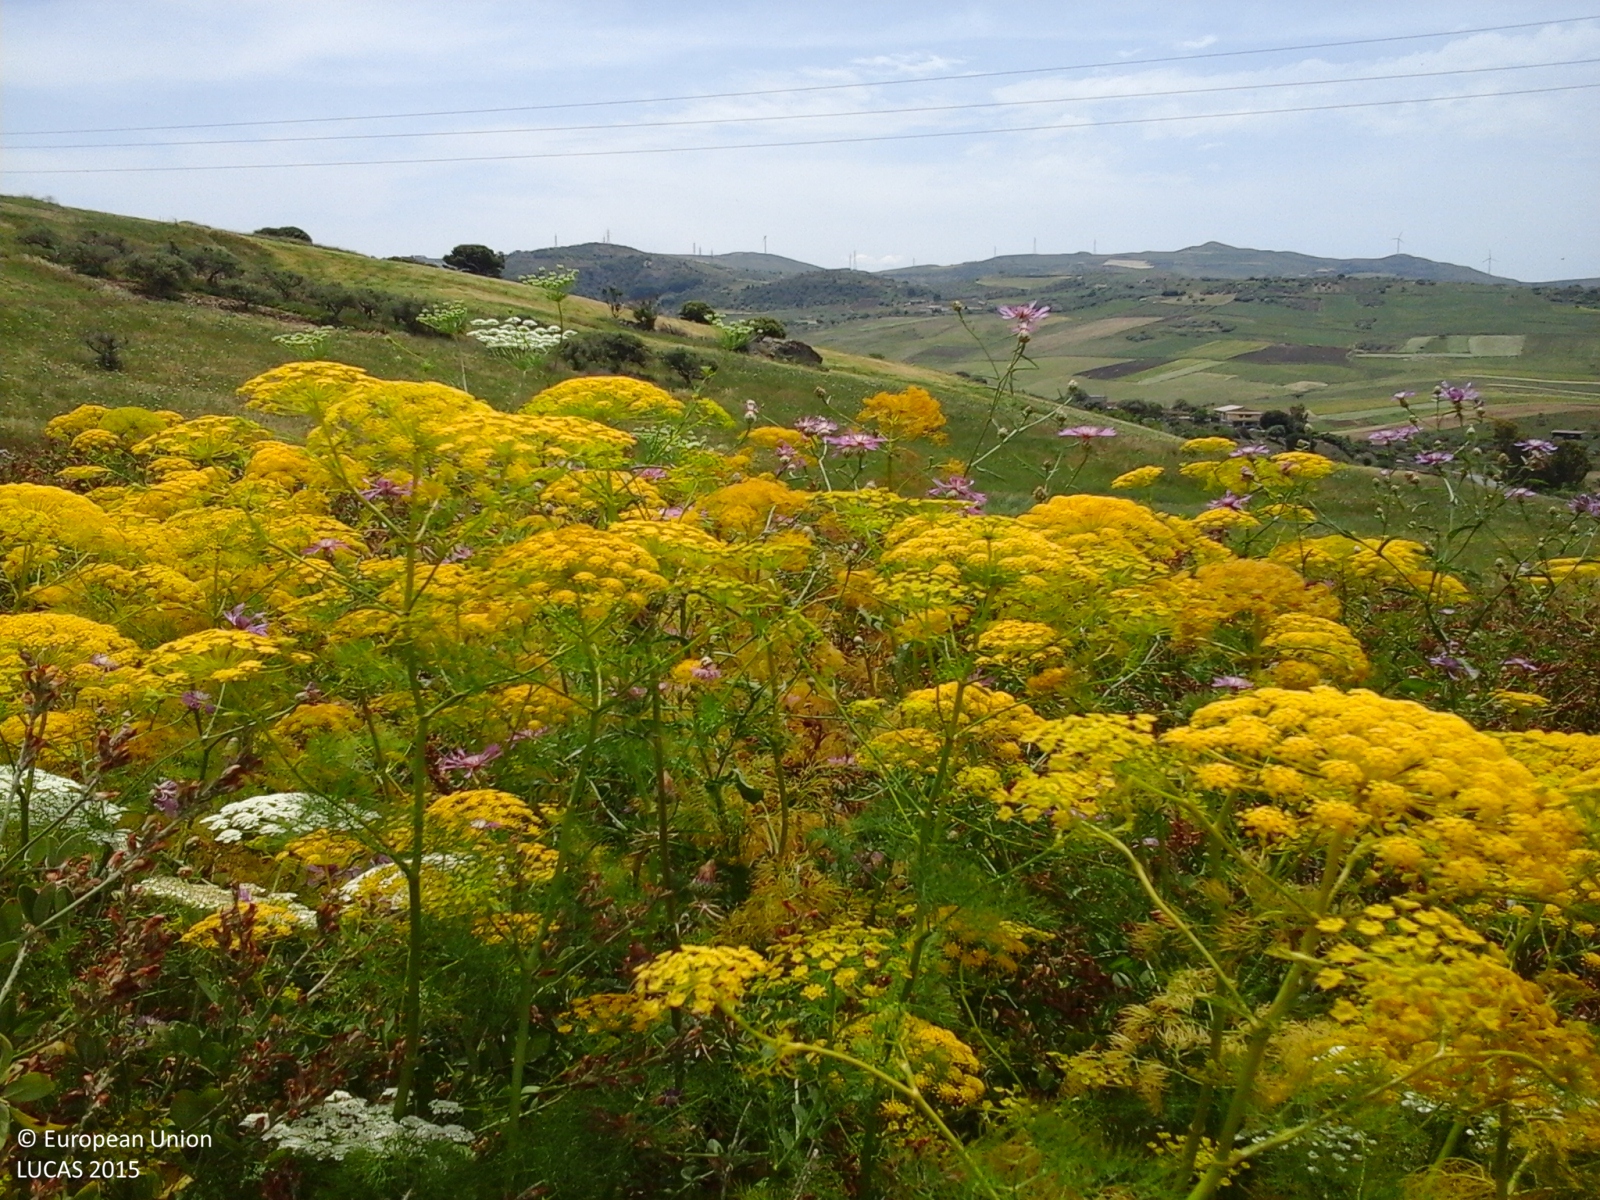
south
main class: Cropland
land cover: Other leguminous and mixtures for fodder
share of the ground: > 75 %
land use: Agriculture (excluding fallow land and kitchen gardens)
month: May
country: IT
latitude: 37.9370
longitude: 13.5135
